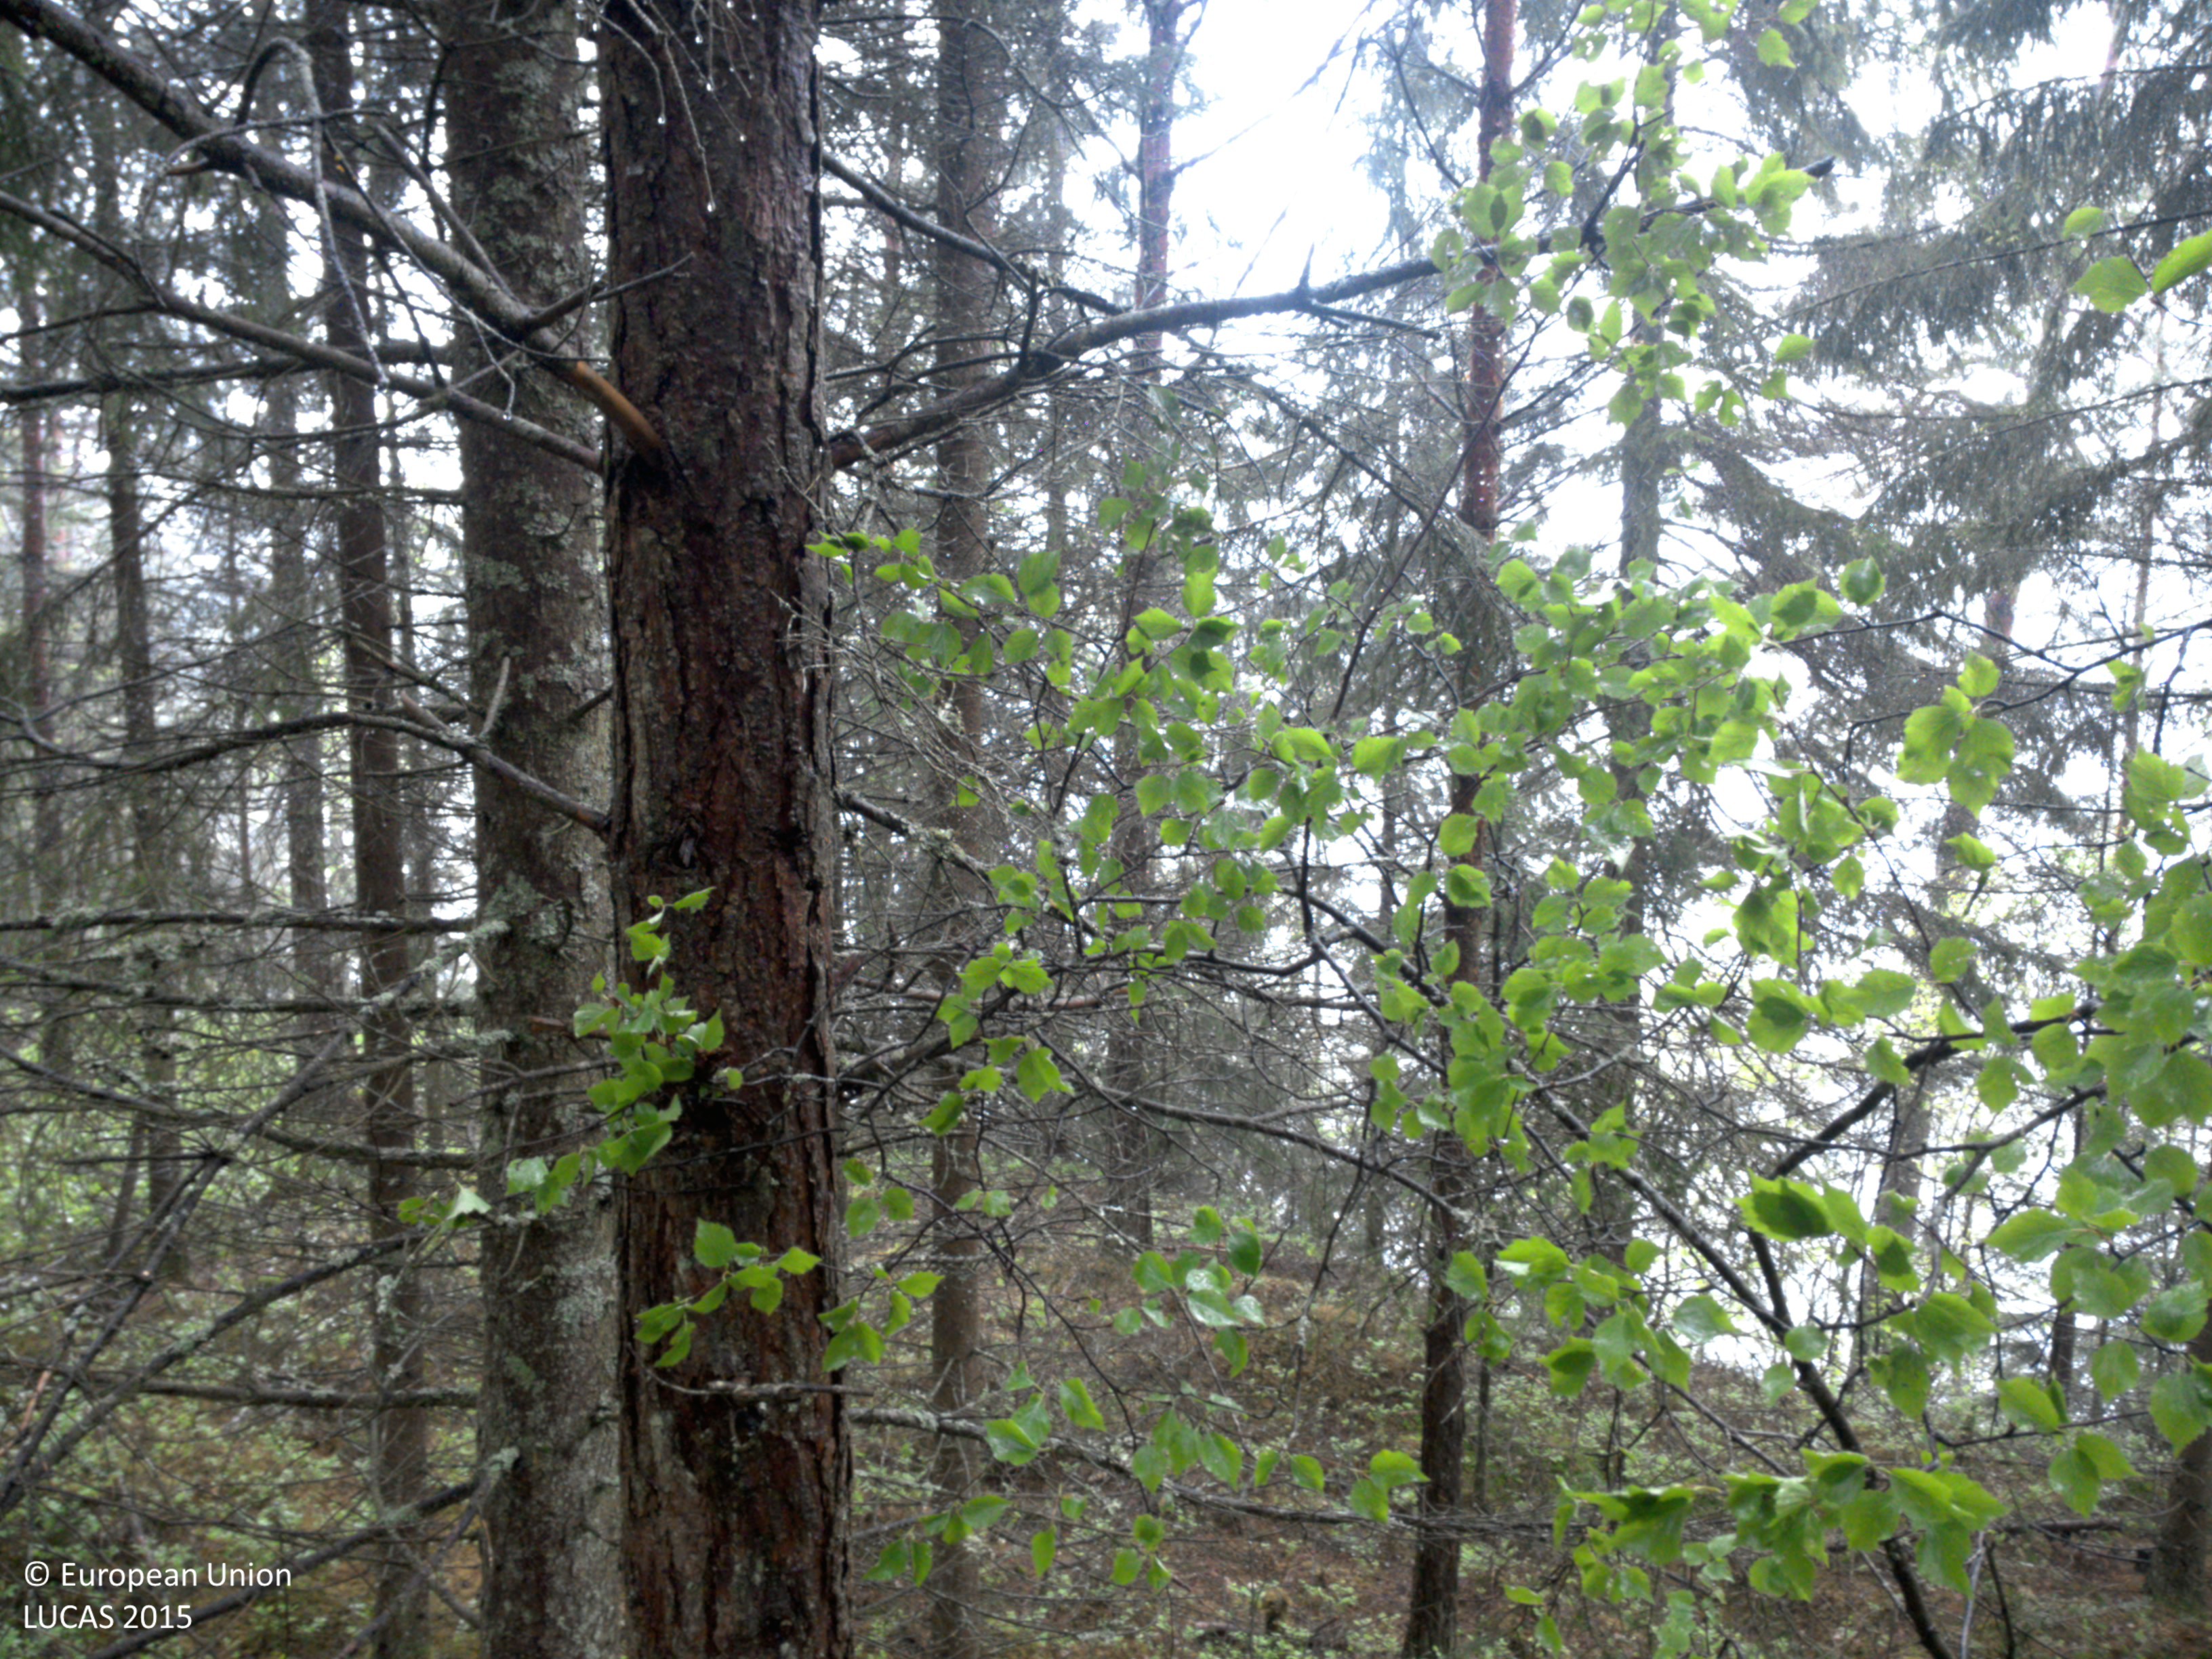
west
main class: Woodland
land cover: Spruce dominated mixed woodland
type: boreal forest
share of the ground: 50 - 75 %
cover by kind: coniferous forest trees 50 %, broadleaved forest trees 25 %, herbaceous plants 20 %, shrubs 5 %
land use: Forestry
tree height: > 5 m
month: June
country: SE
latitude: 57.8764
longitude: 12.2724
